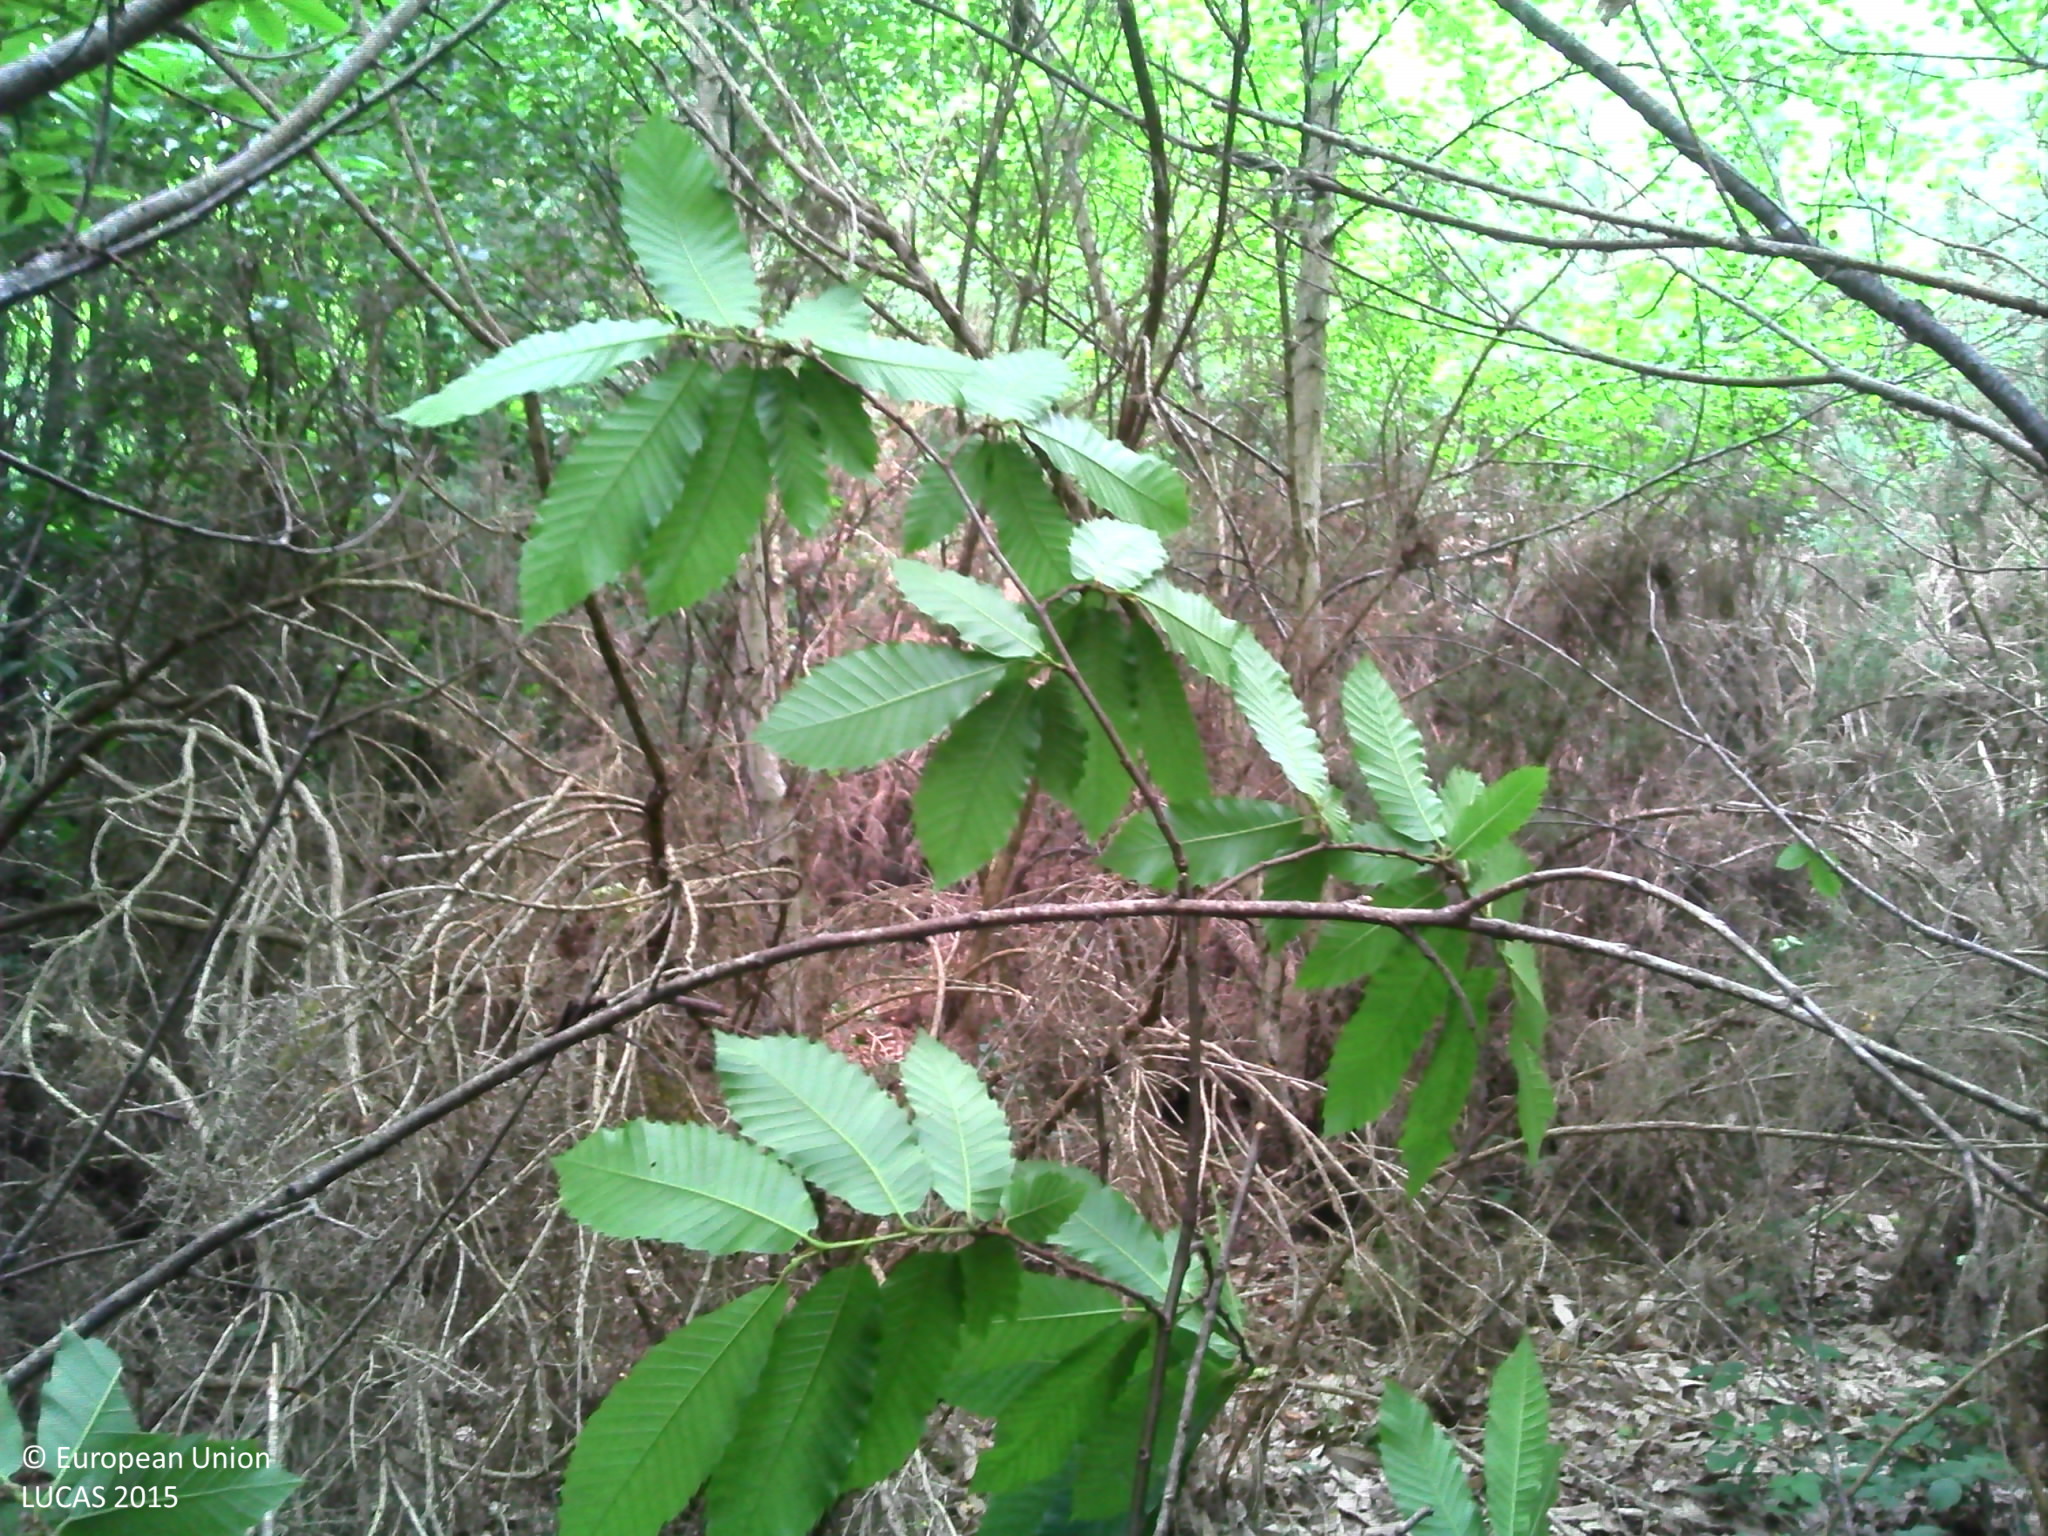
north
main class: Woodland
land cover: Broadleaved woodland
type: thermophilous deciduous forest
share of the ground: > 75 %
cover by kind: broadleaved forest trees 100 %
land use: Forestry
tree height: > 5 m
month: June
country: FR
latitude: 45.9298
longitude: 0.3244
